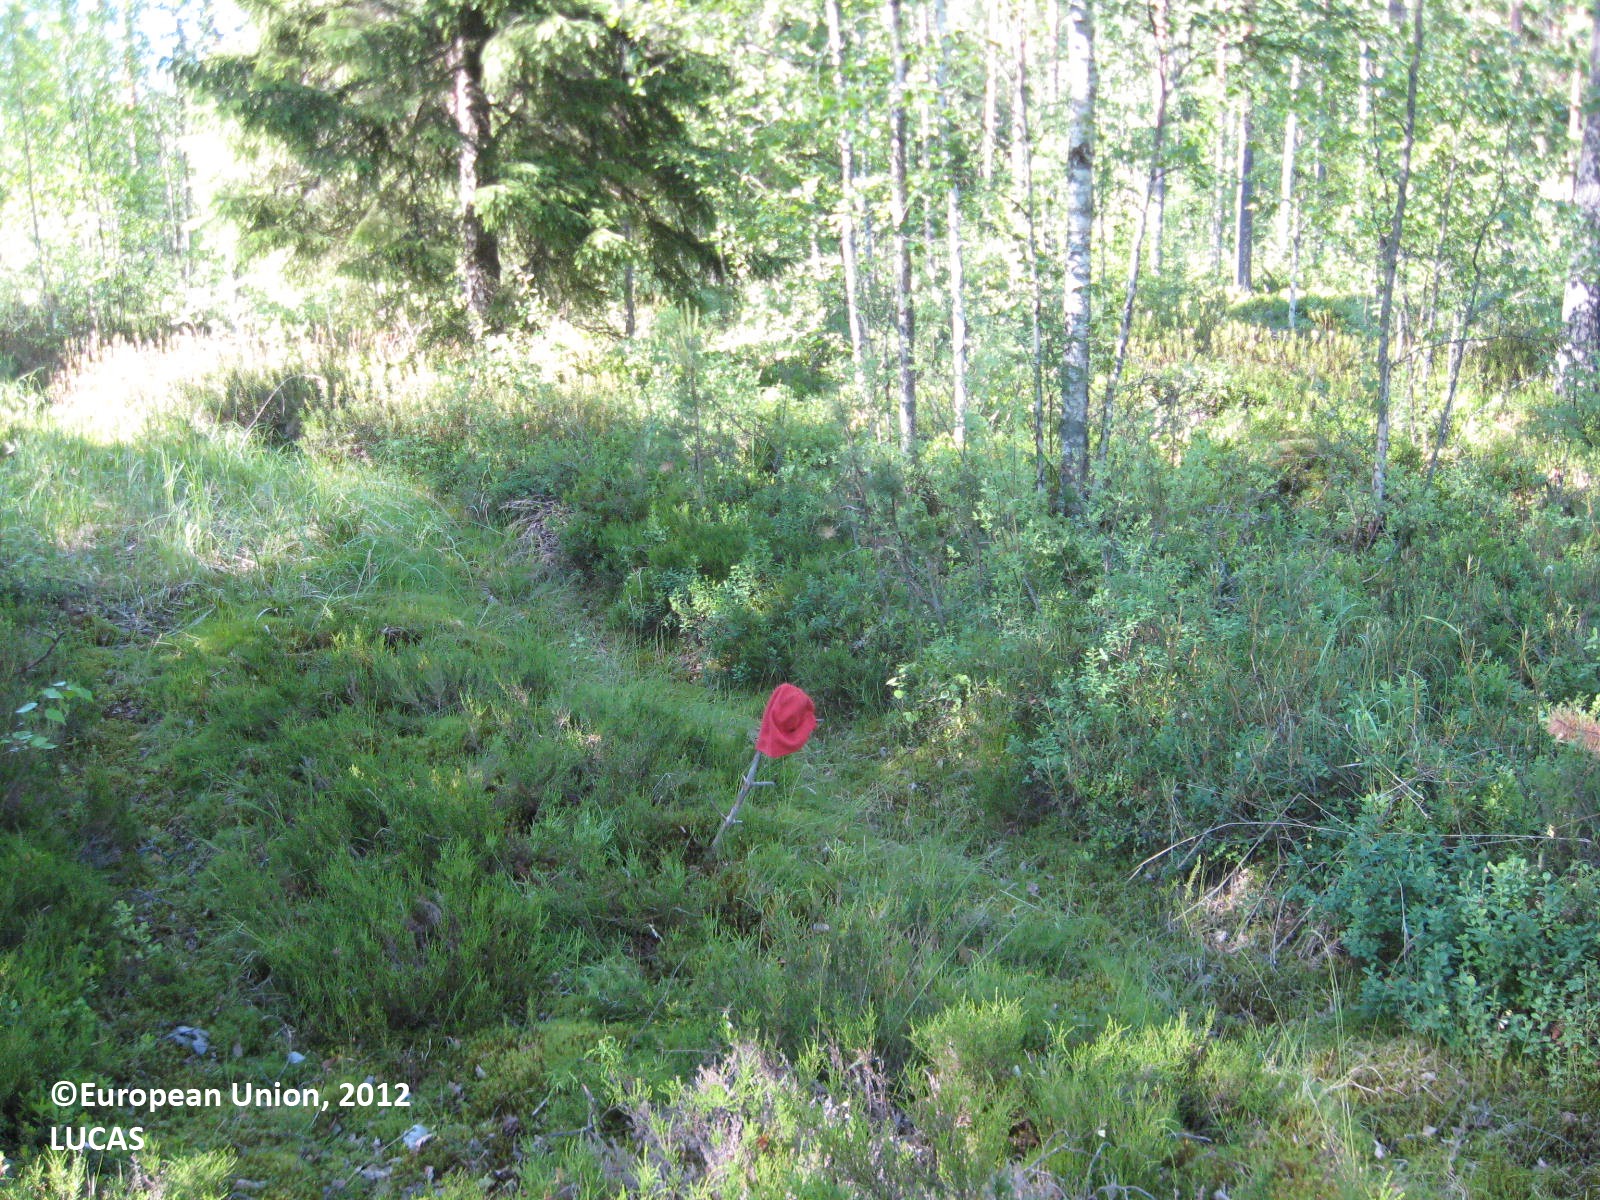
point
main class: Woodland
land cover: Other mixed woodland
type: boreal forest
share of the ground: > 75 %
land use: Forestry
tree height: > 5 m
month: July
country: FI
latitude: 62.6992
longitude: 22.8598
